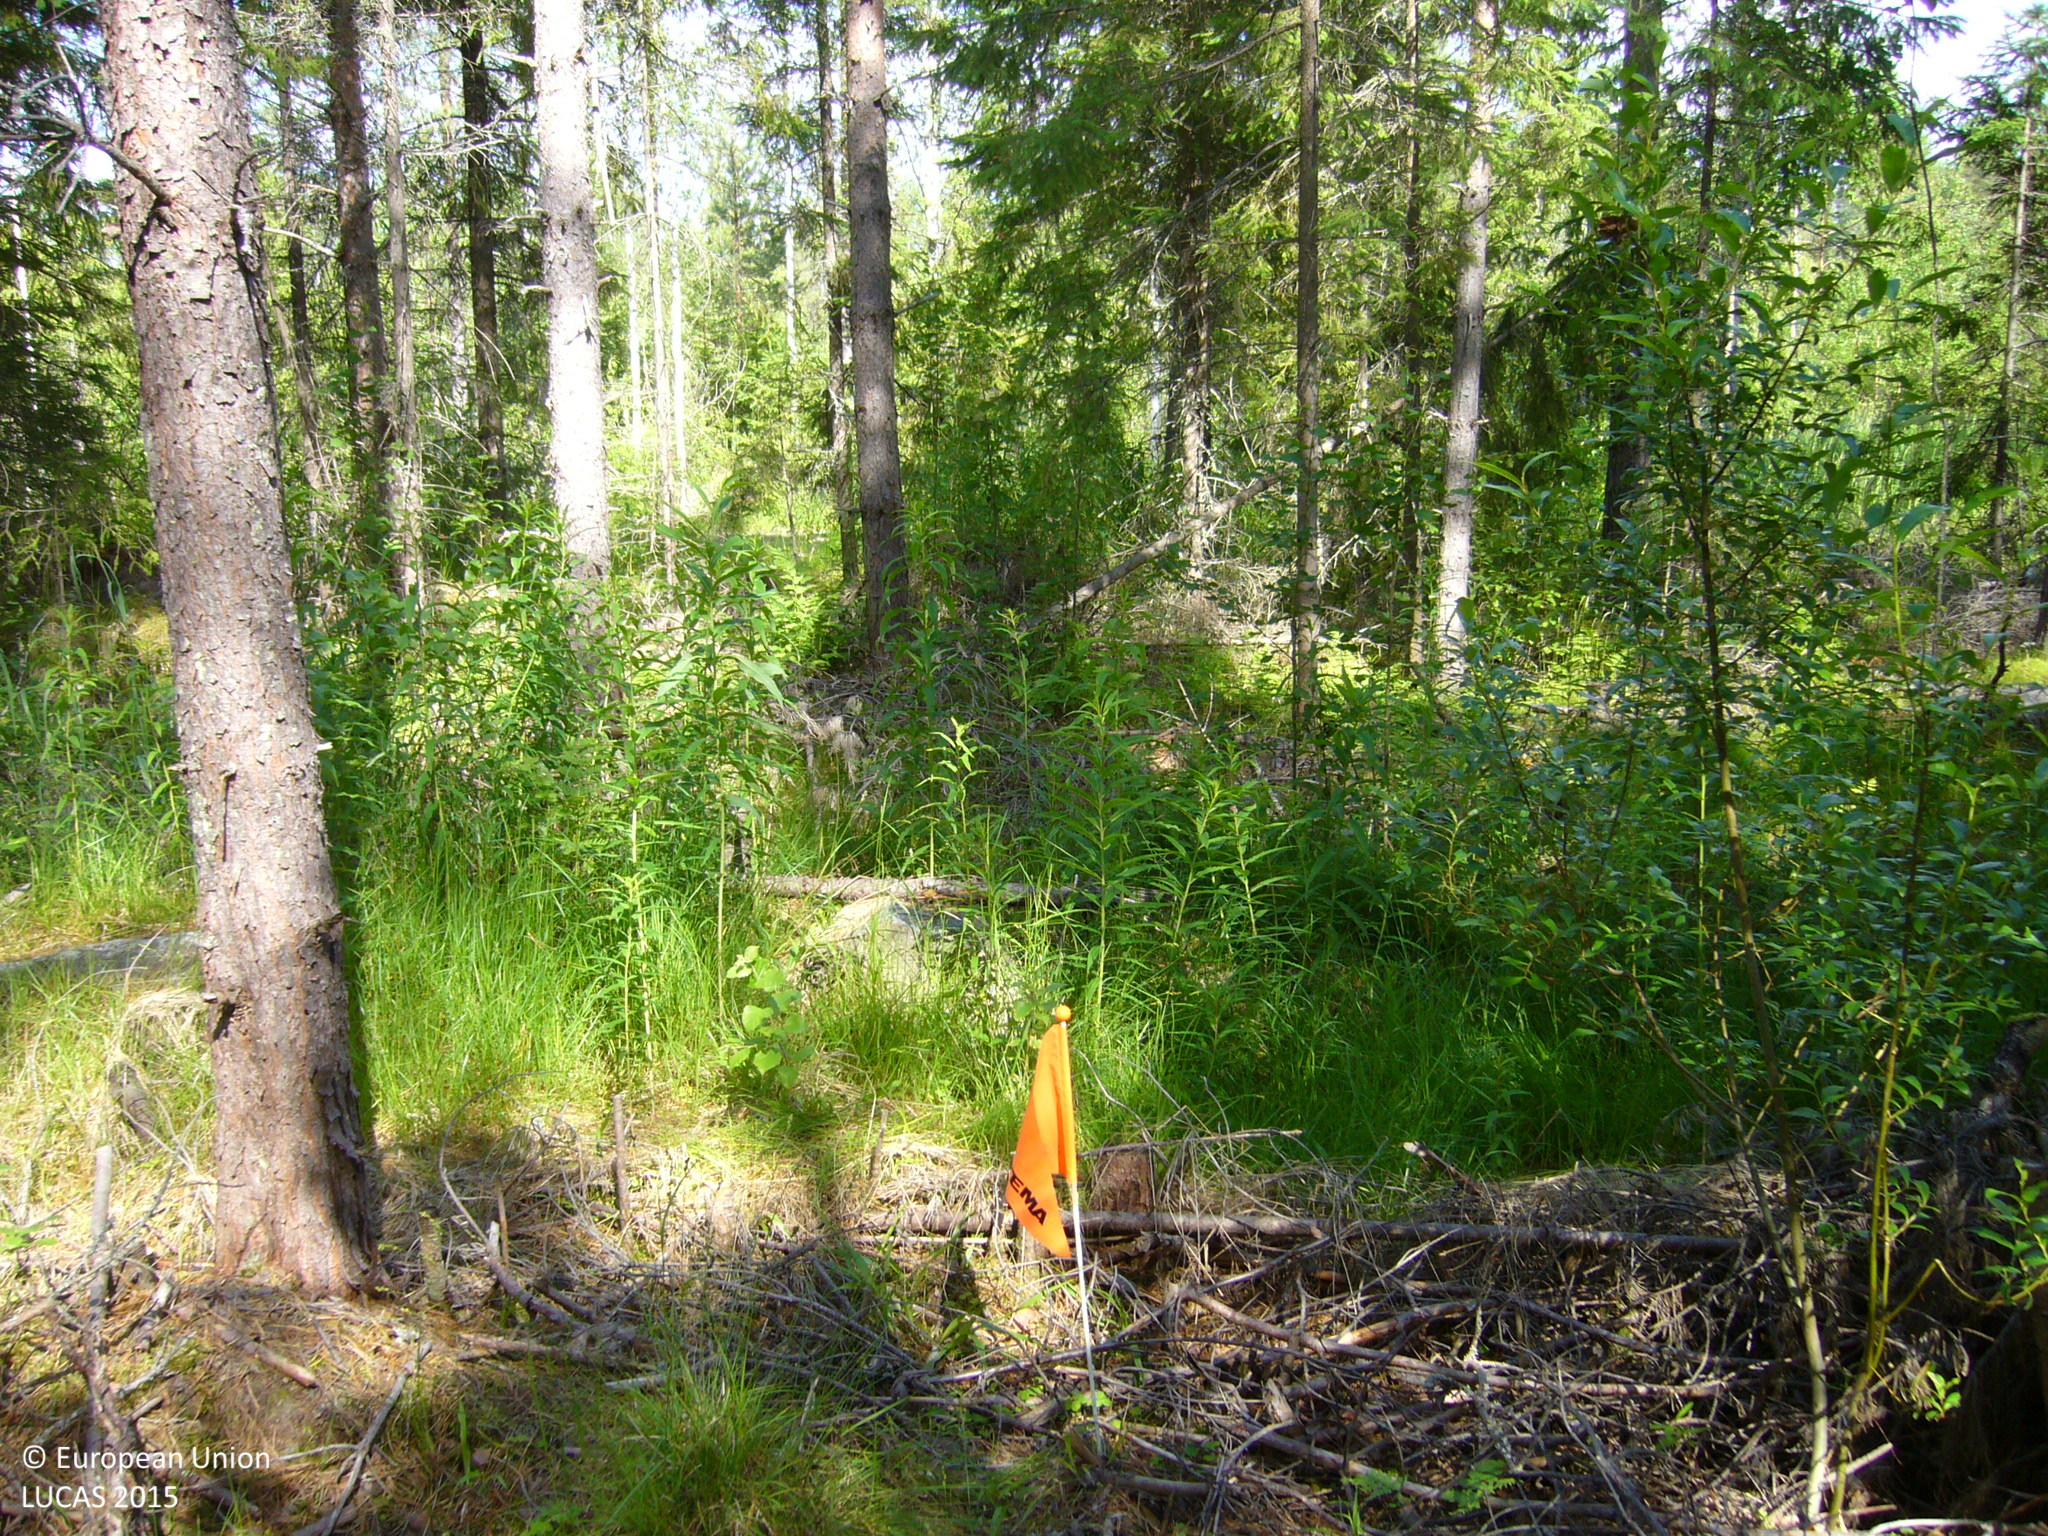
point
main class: Woodland
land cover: Pine dominated coniferous woodland
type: boreal forest
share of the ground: 50 - 75 %
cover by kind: coniferous forest trees 60 %, shrubs 40 %
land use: Forestry
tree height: > 5 m
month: July
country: FI
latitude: 63.3443
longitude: 26.2859
